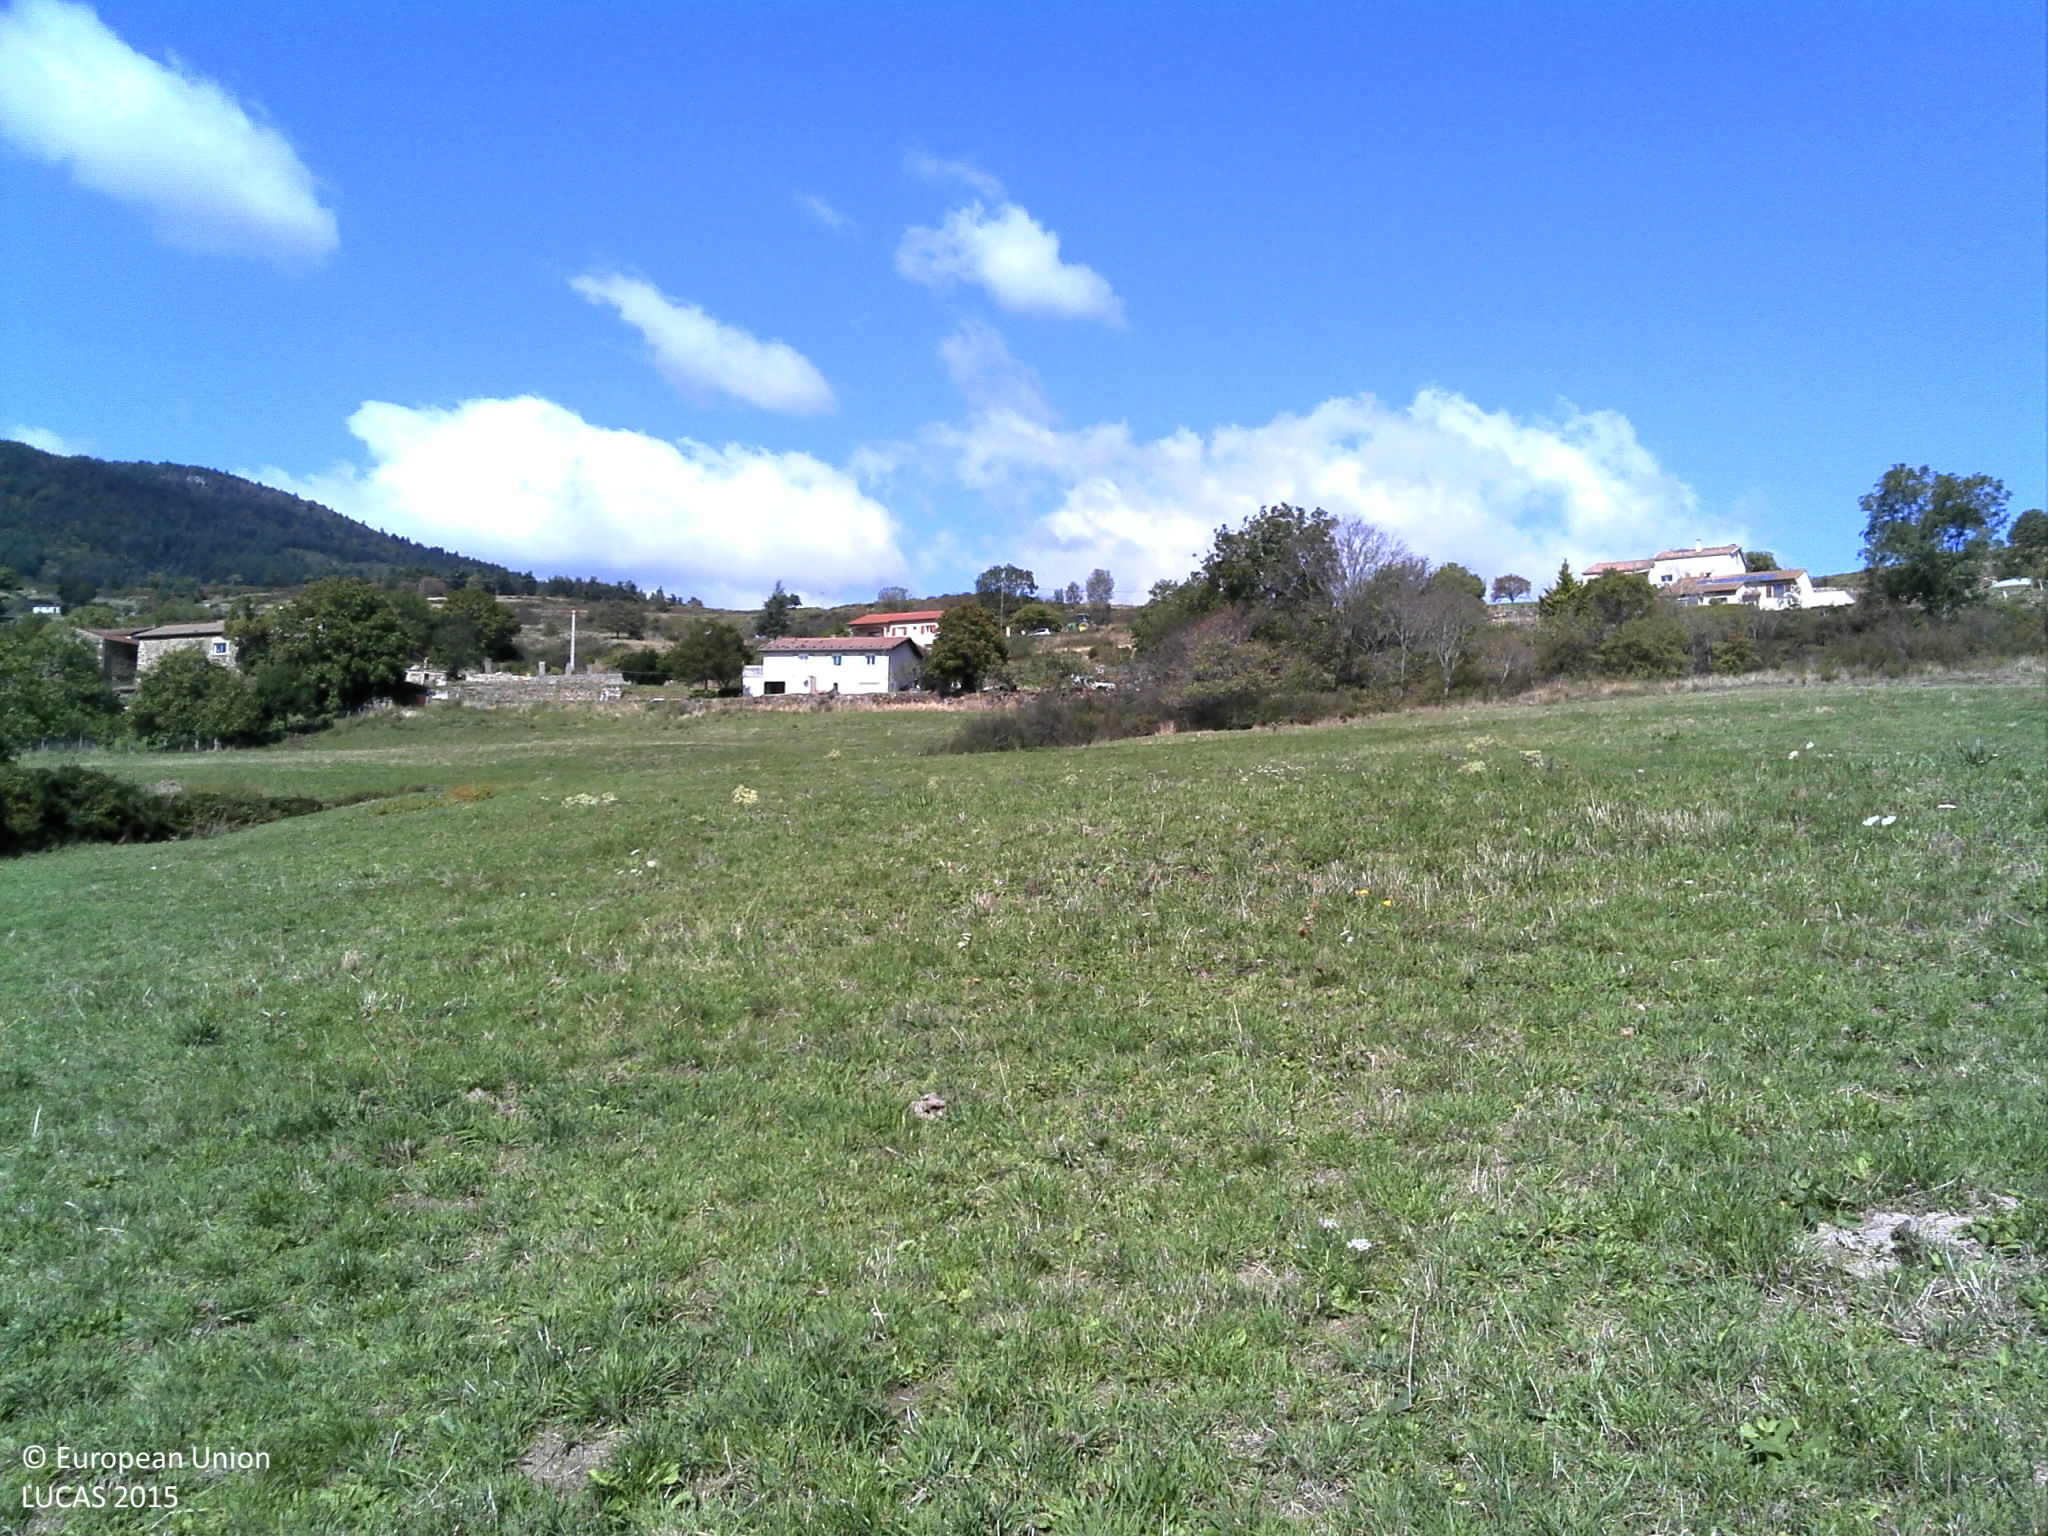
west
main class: Grassland
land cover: Grassland without tree/shrub cover
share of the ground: > 75 %
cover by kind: herbaceous plants 100 %
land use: Agriculture (excluding fallow land and kitchen gardens)
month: September
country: FR
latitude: 45.2380
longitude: 4.5652
